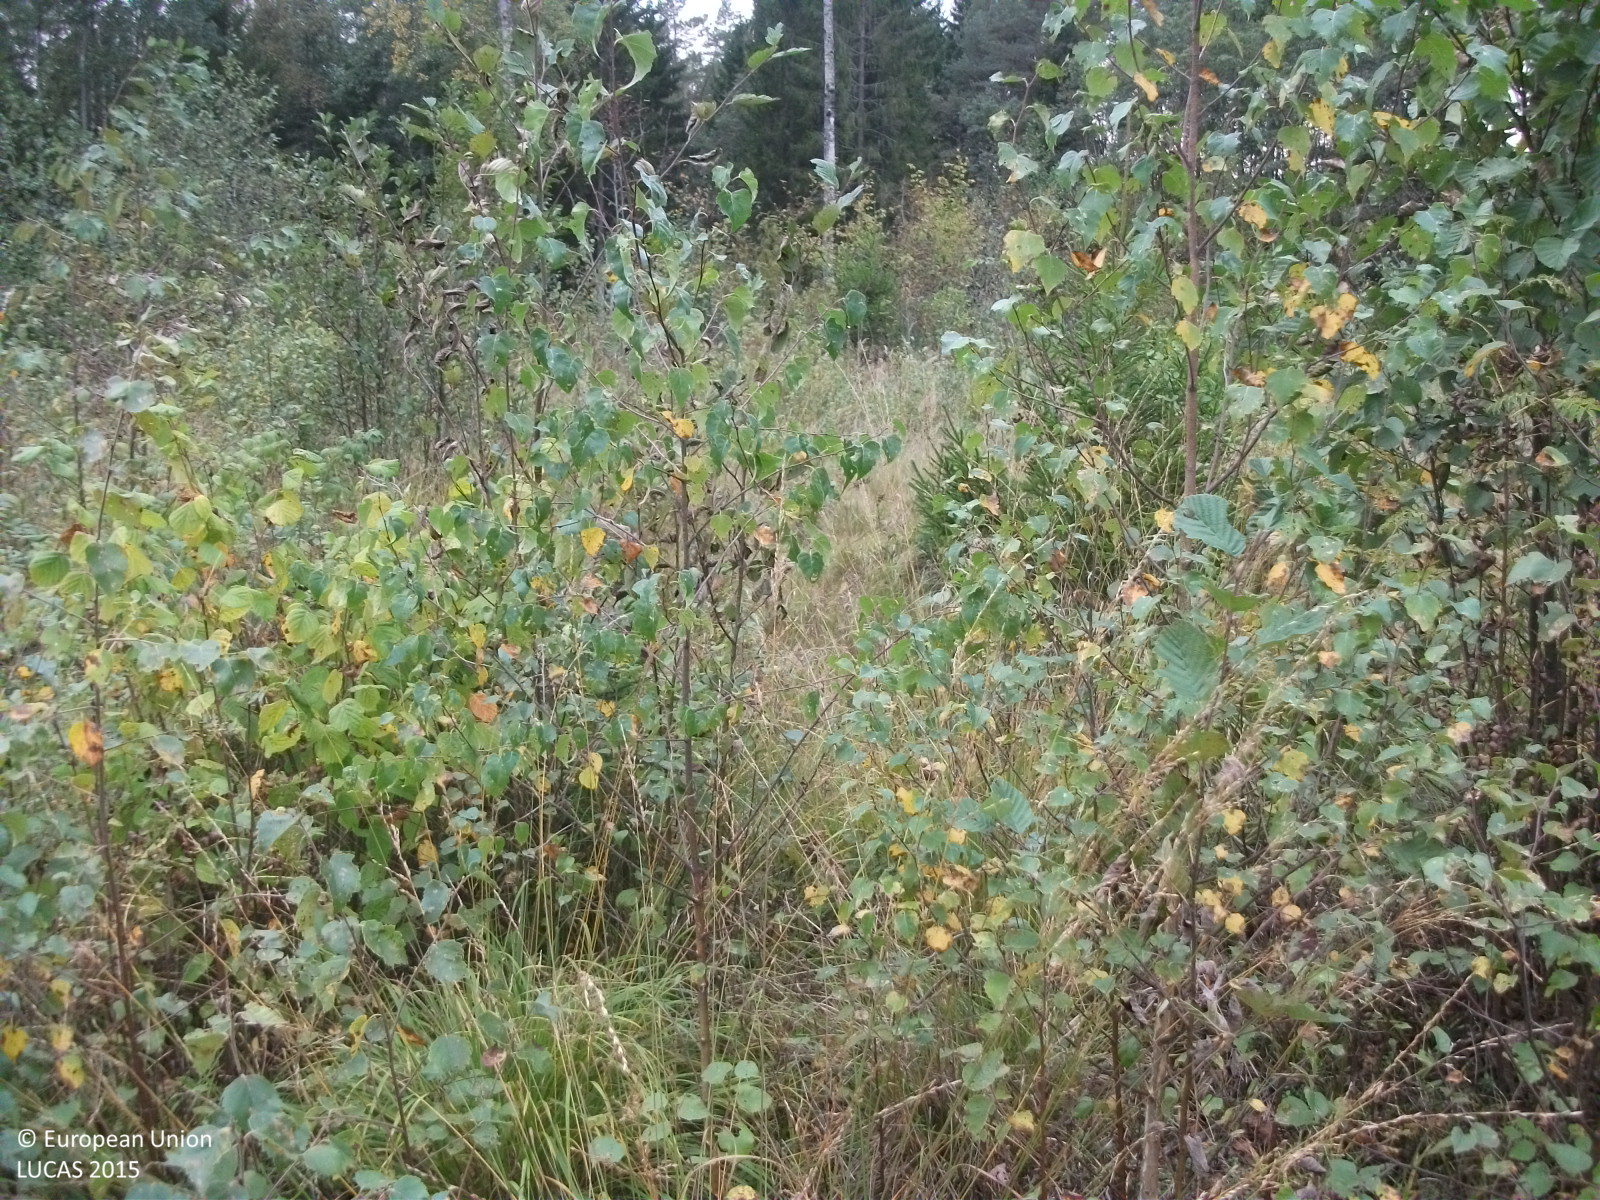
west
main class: Woodland
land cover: Spruce dominated mixed woodland
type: hemiboreal forest and nemoral coniferous forest and mixed broadleaved-coniferous forest
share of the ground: 25 - 50 %
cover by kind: broadleaved forest trees 30 %, shrubs 30 %, herbaceous plants 25 %, coniferous forest trees 15 %
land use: Forestry
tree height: < 5 m
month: September
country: LV
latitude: 57.9084
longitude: 24.6218
